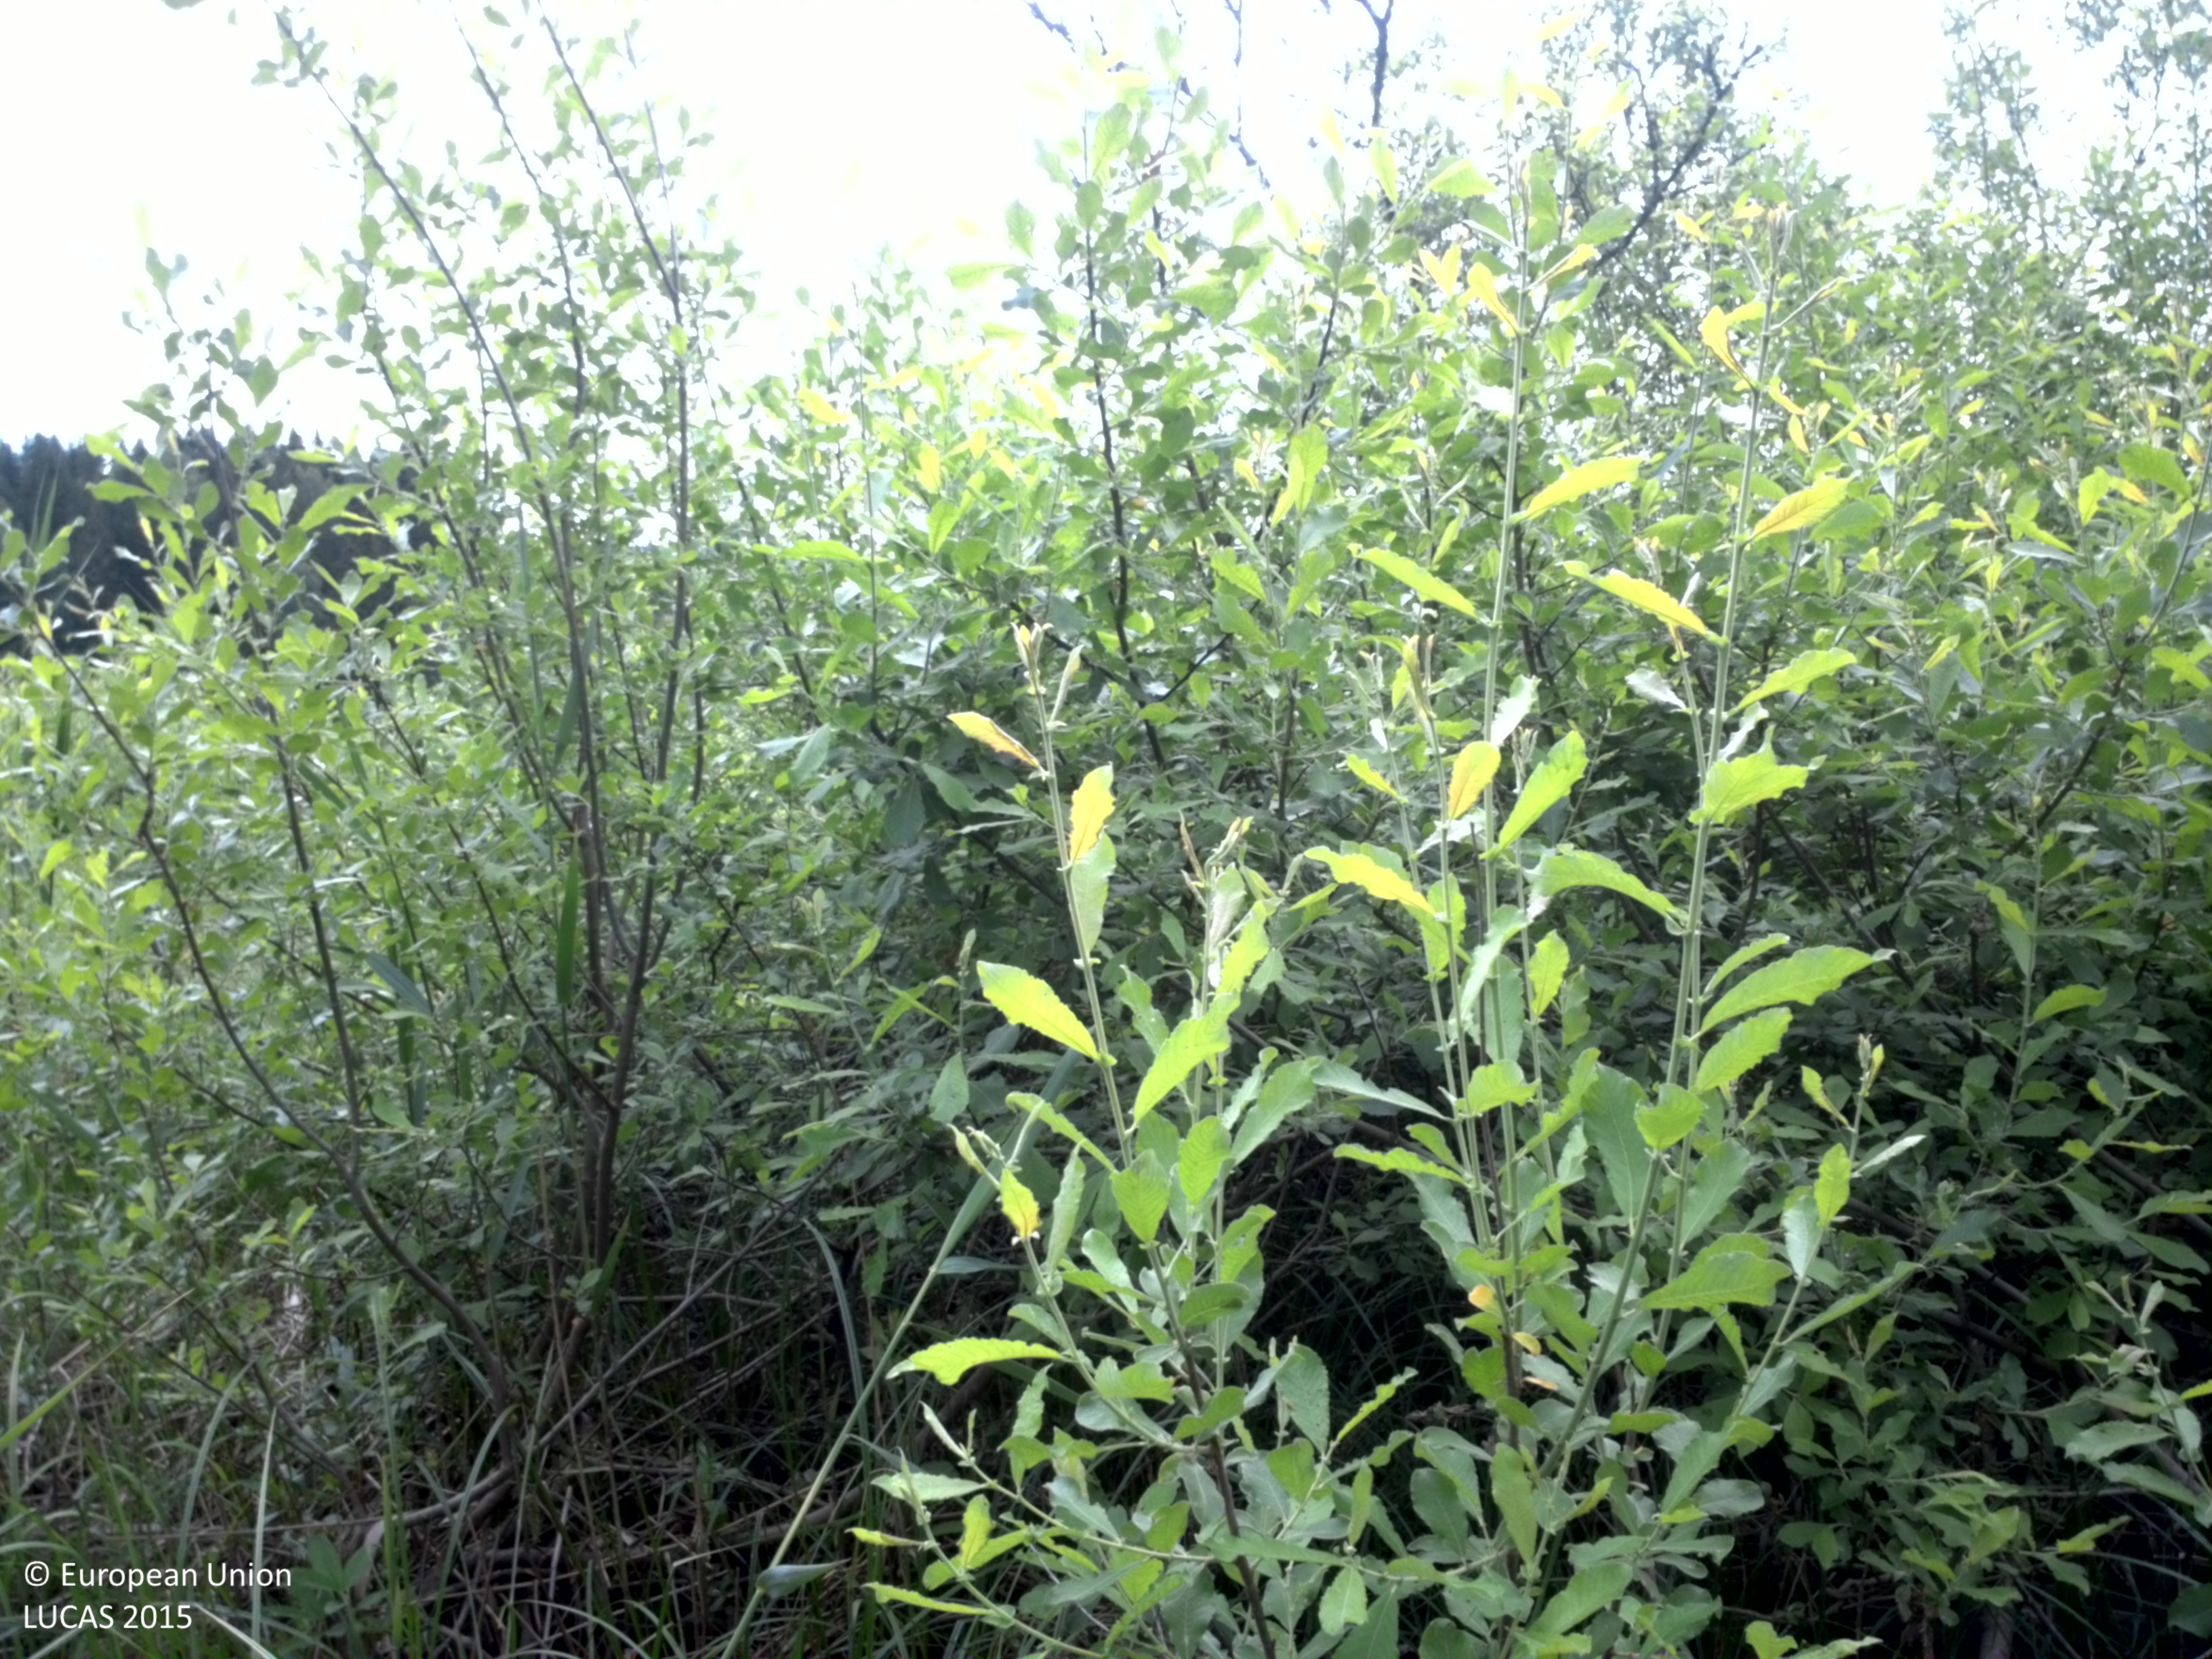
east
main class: Shrubland
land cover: Shrubland with sparse tree cover
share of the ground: 50 - 75 %
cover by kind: shrubs 55 %, herbaceous plants 40 %, broadleaved forest trees 5 %
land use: Semi-natural and natural areas not in use
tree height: < 5 m
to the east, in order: Shrubland with sparse tree cover; Inland marshes; Inland fresh water bodies; Inland marshes; Broadleaved woodland
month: July
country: SE
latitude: 59.8062
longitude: 12.0087
